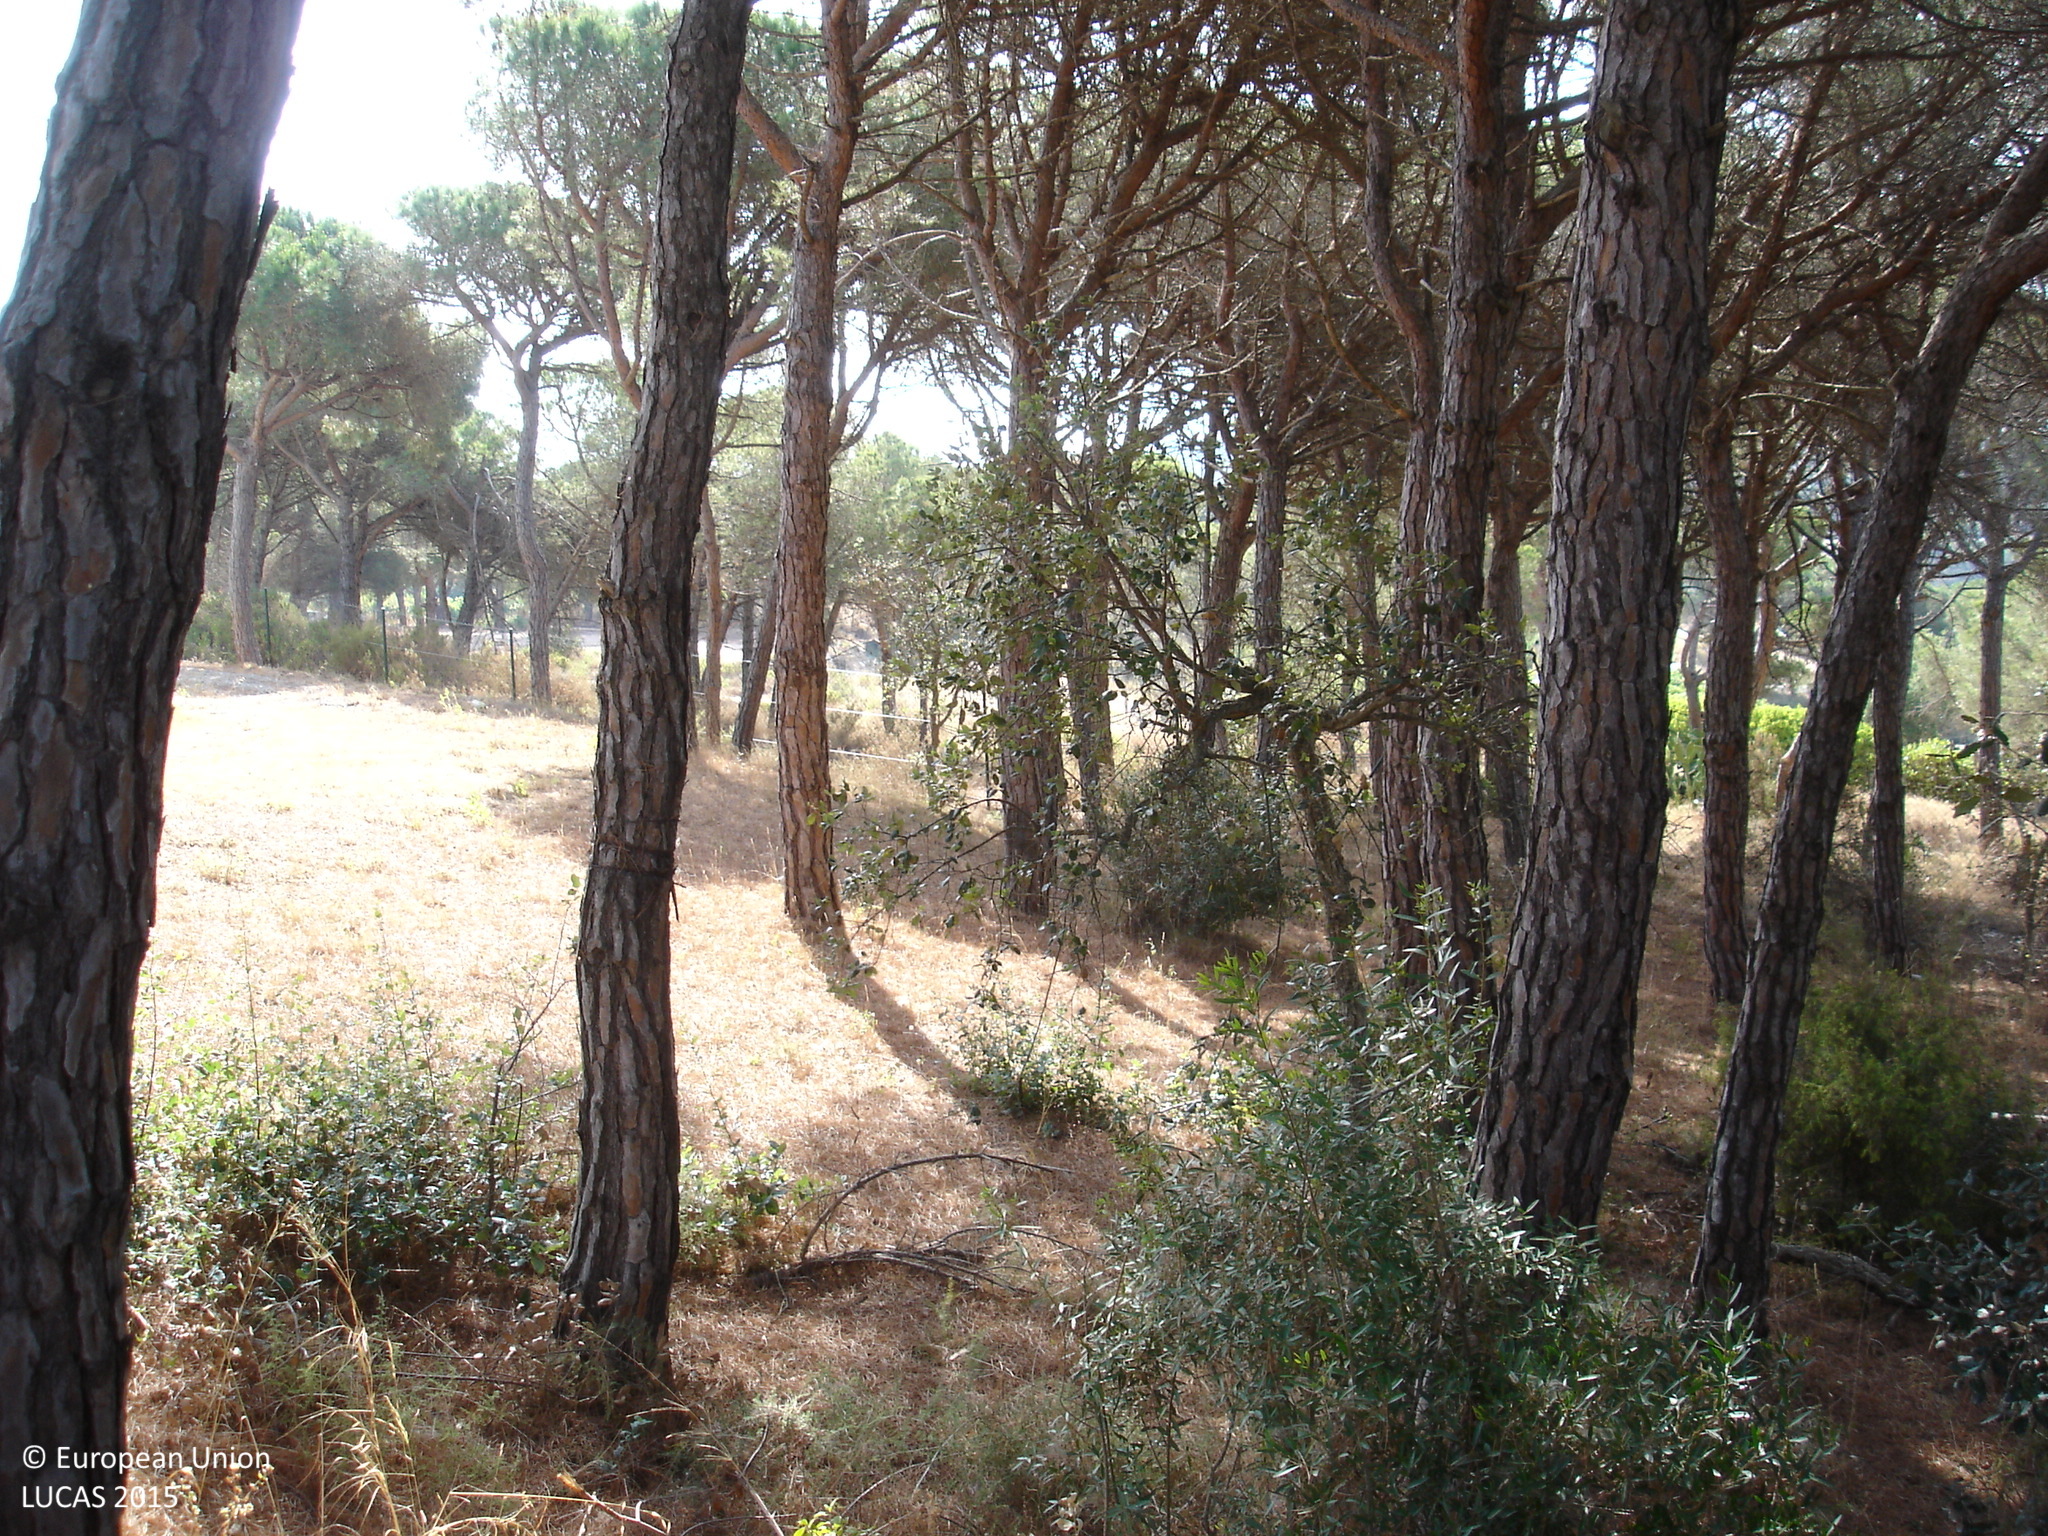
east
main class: Woodland
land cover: Pine dominated coniferous woodland
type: coniferous forest of the mediterranean region
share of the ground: 50 - 75 %
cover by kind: coniferous forest trees 70 %, herbaceous plants 25 %, broadleaved forest trees 5 %
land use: Forestry
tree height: > 5 m
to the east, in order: Pine dominated coniferous woodland; Fences; Grassland without tree/shrub cover; Artificial constructions in urban areas; Pine dominated coniferous woodland; Fences; Pine dominated coniferous woodland; Shruby margins; Tracks; Pine dominated coniferous woodland; Tracks; Grassland with sparse tree/shrub cover; Pine dominated coniferous woodland; Tracks; Pine dominated coniferous woodland; Single bushes/trees; Tracks; Grassland with sparse tree/shrub cover; Artificial constructions in urban areas; Grassland with sparse tree/shrub cover
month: July
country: ES
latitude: 41.7971
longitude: 3.0247
